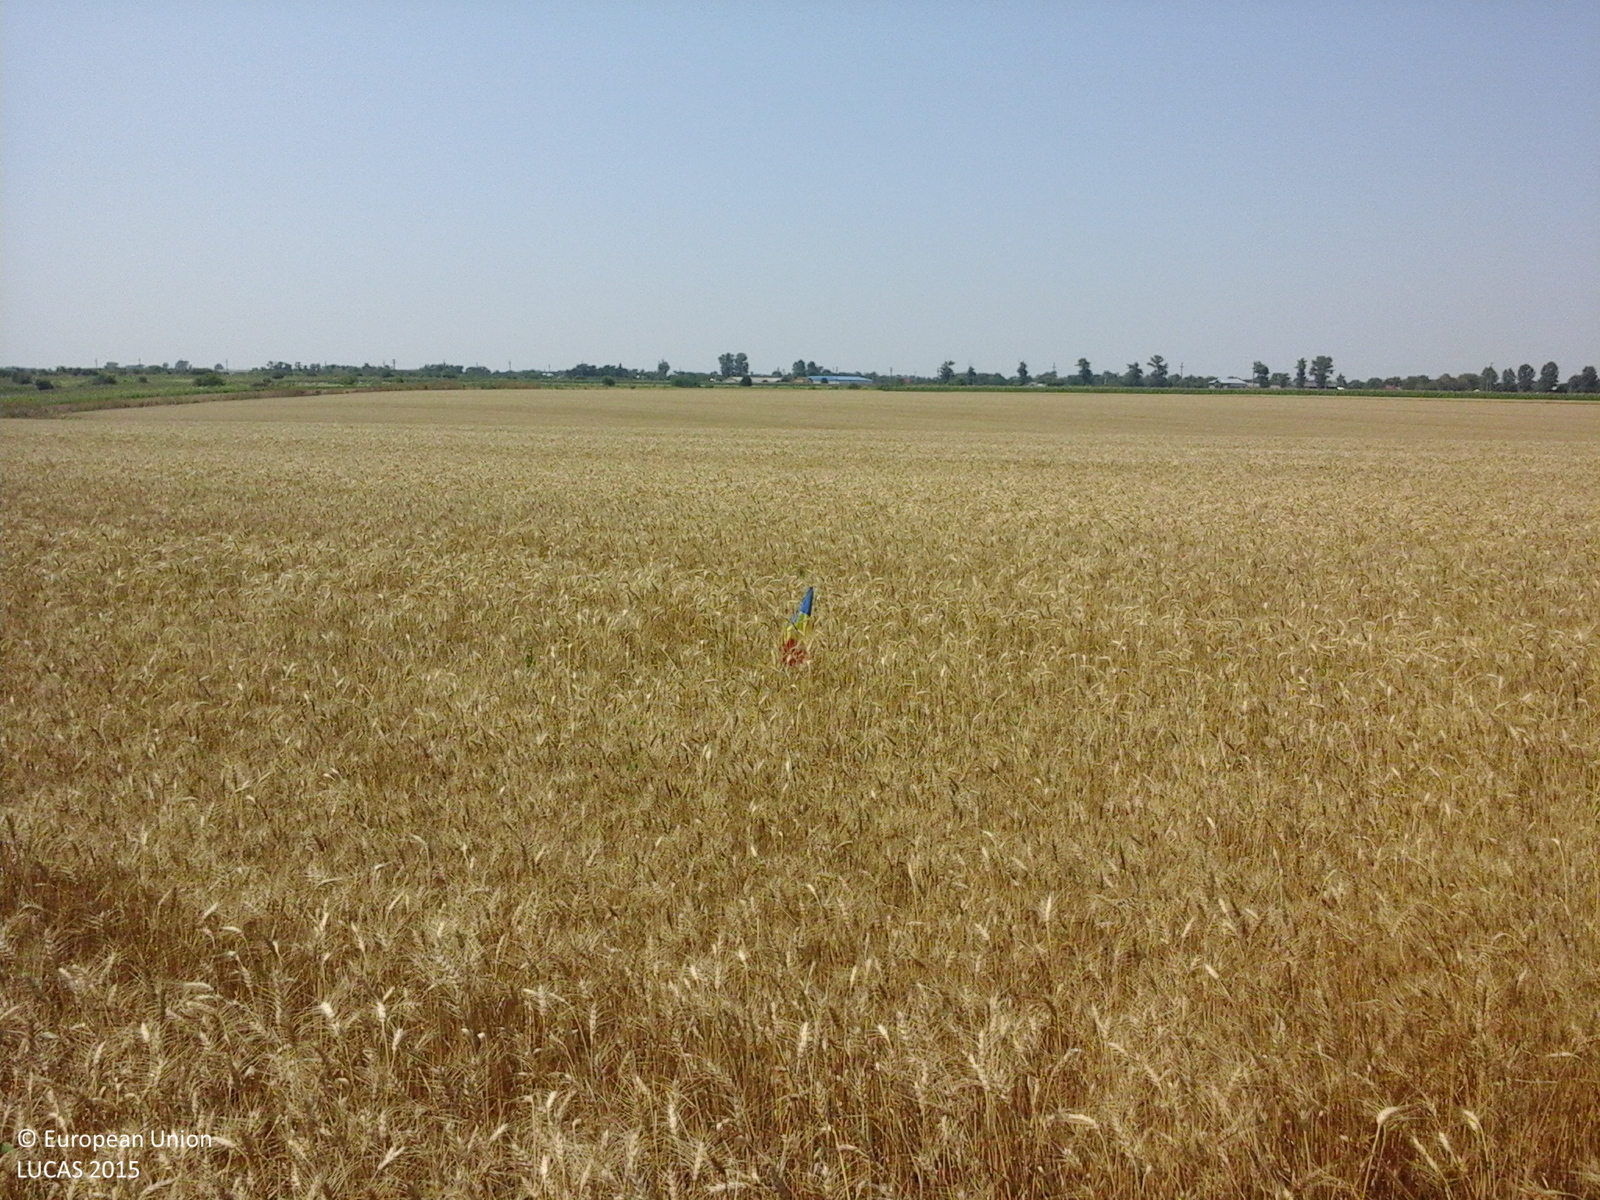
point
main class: Cropland
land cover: Common wheat
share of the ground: > 75 %
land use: Agriculture (excluding fallow land and kitchen gardens)
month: July
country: RO
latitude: 44.2026
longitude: 25.3905
